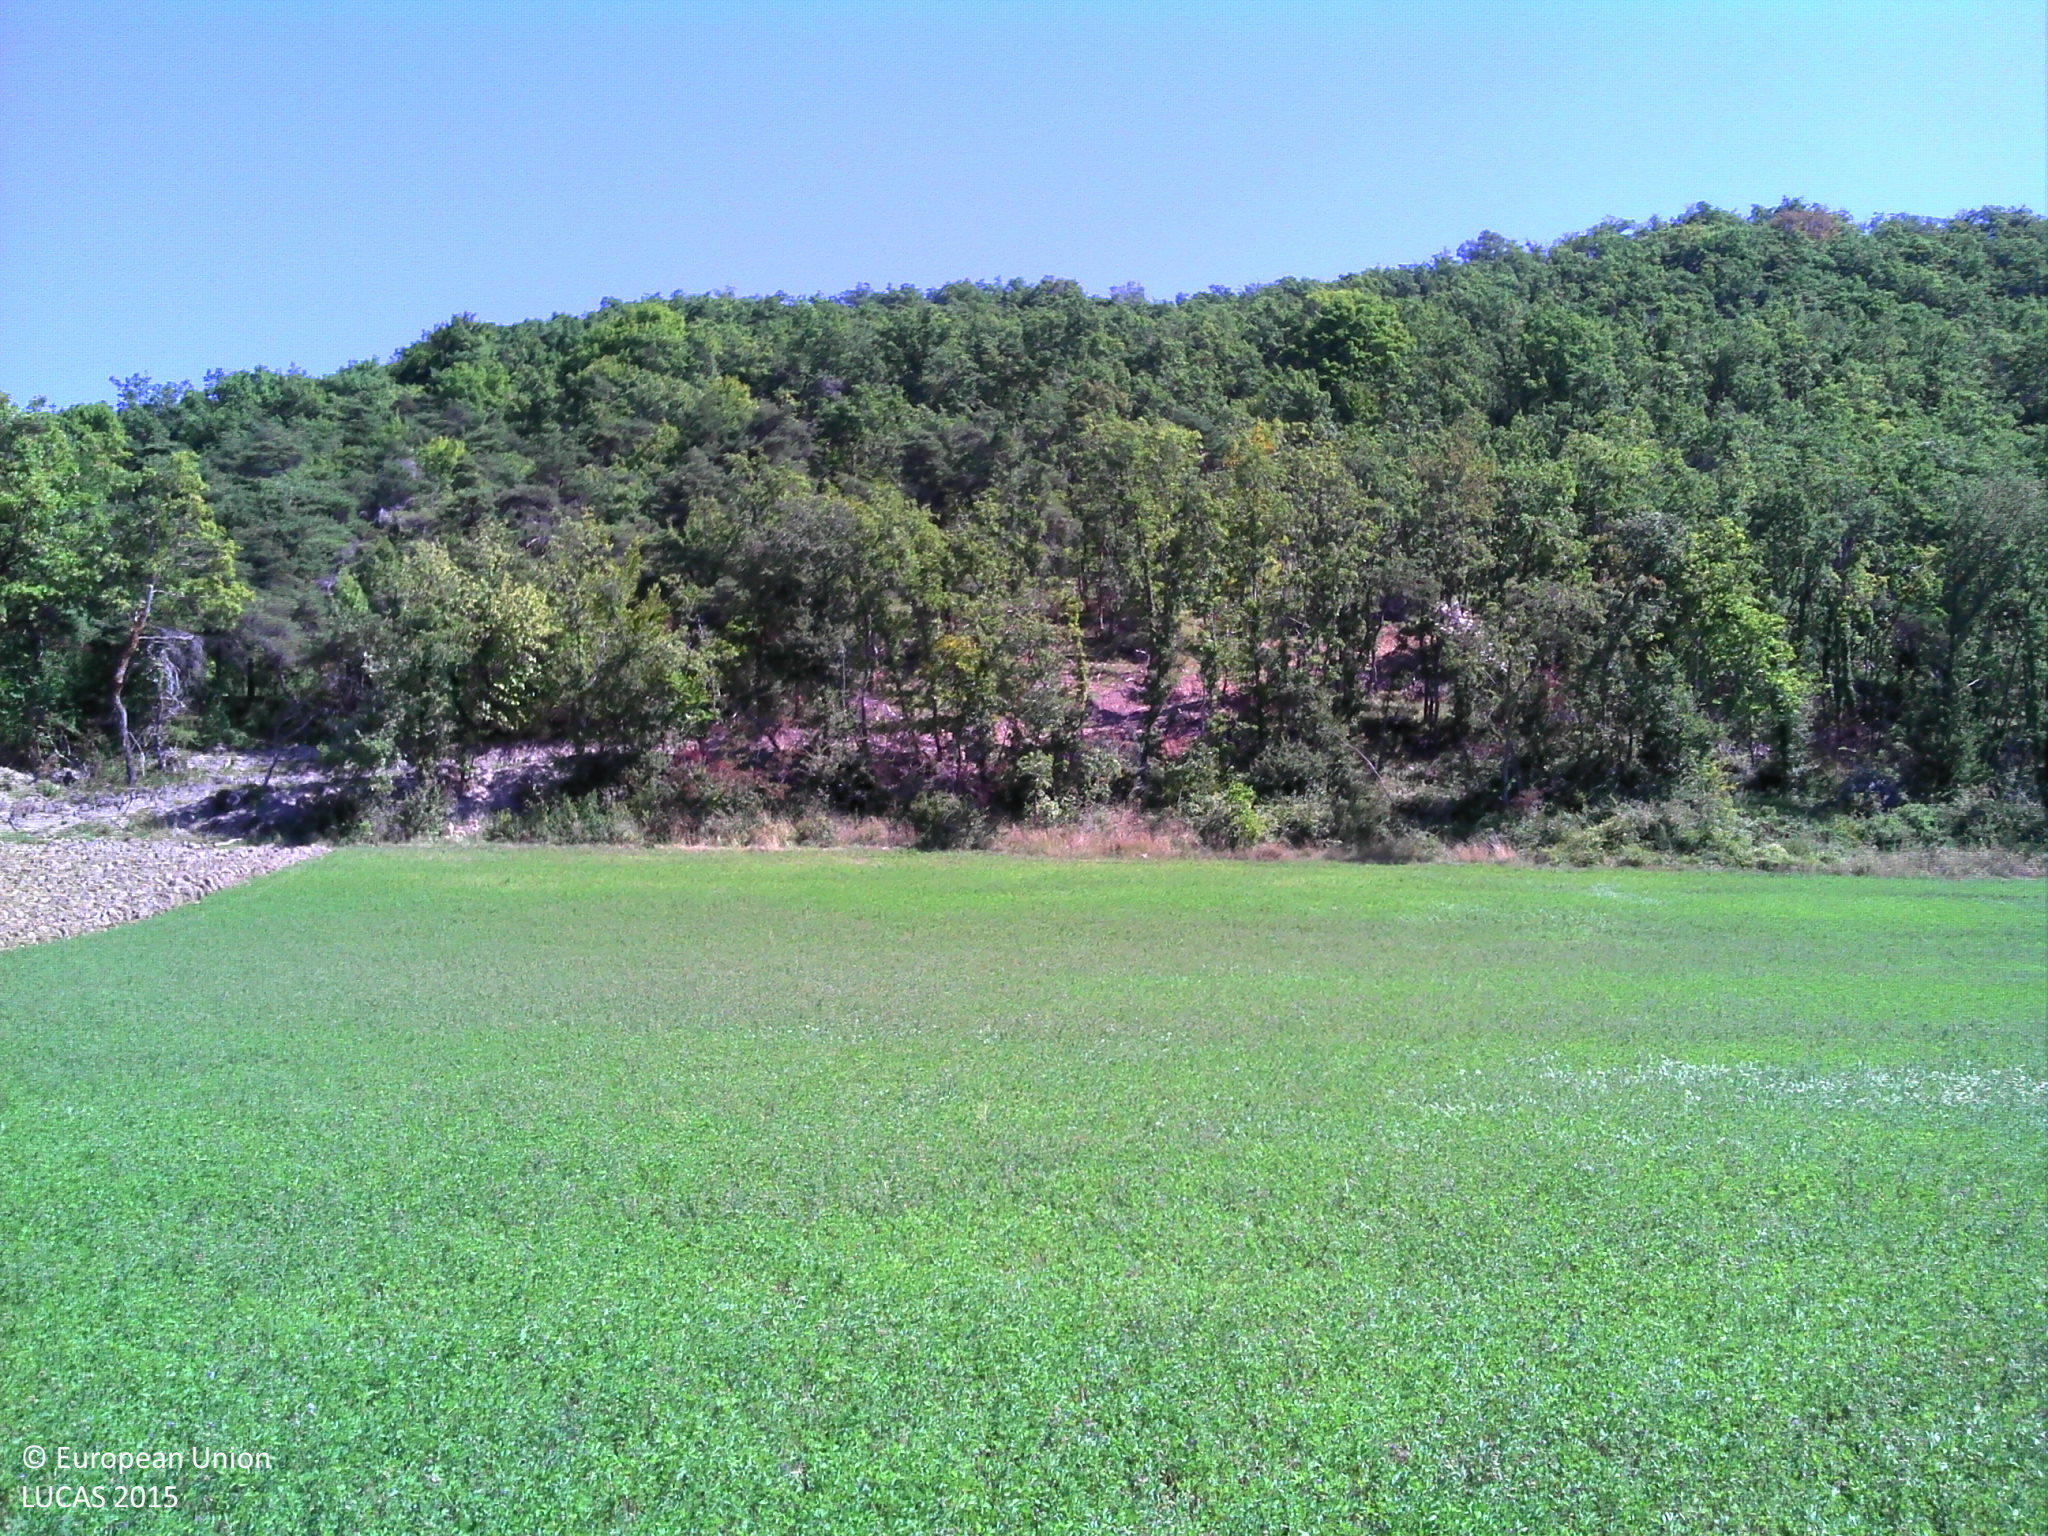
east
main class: Cropland
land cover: Lucerne
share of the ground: > 75 %
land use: Agriculture (excluding fallow land and kitchen gardens)
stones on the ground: 25 - 50 %
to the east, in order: Lucerne; Broadleaved woodland; Tracks; Broadleaved woodland; Tracks; Broadleaved woodland
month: September
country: FR
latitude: 44.6852
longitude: 5.0733
